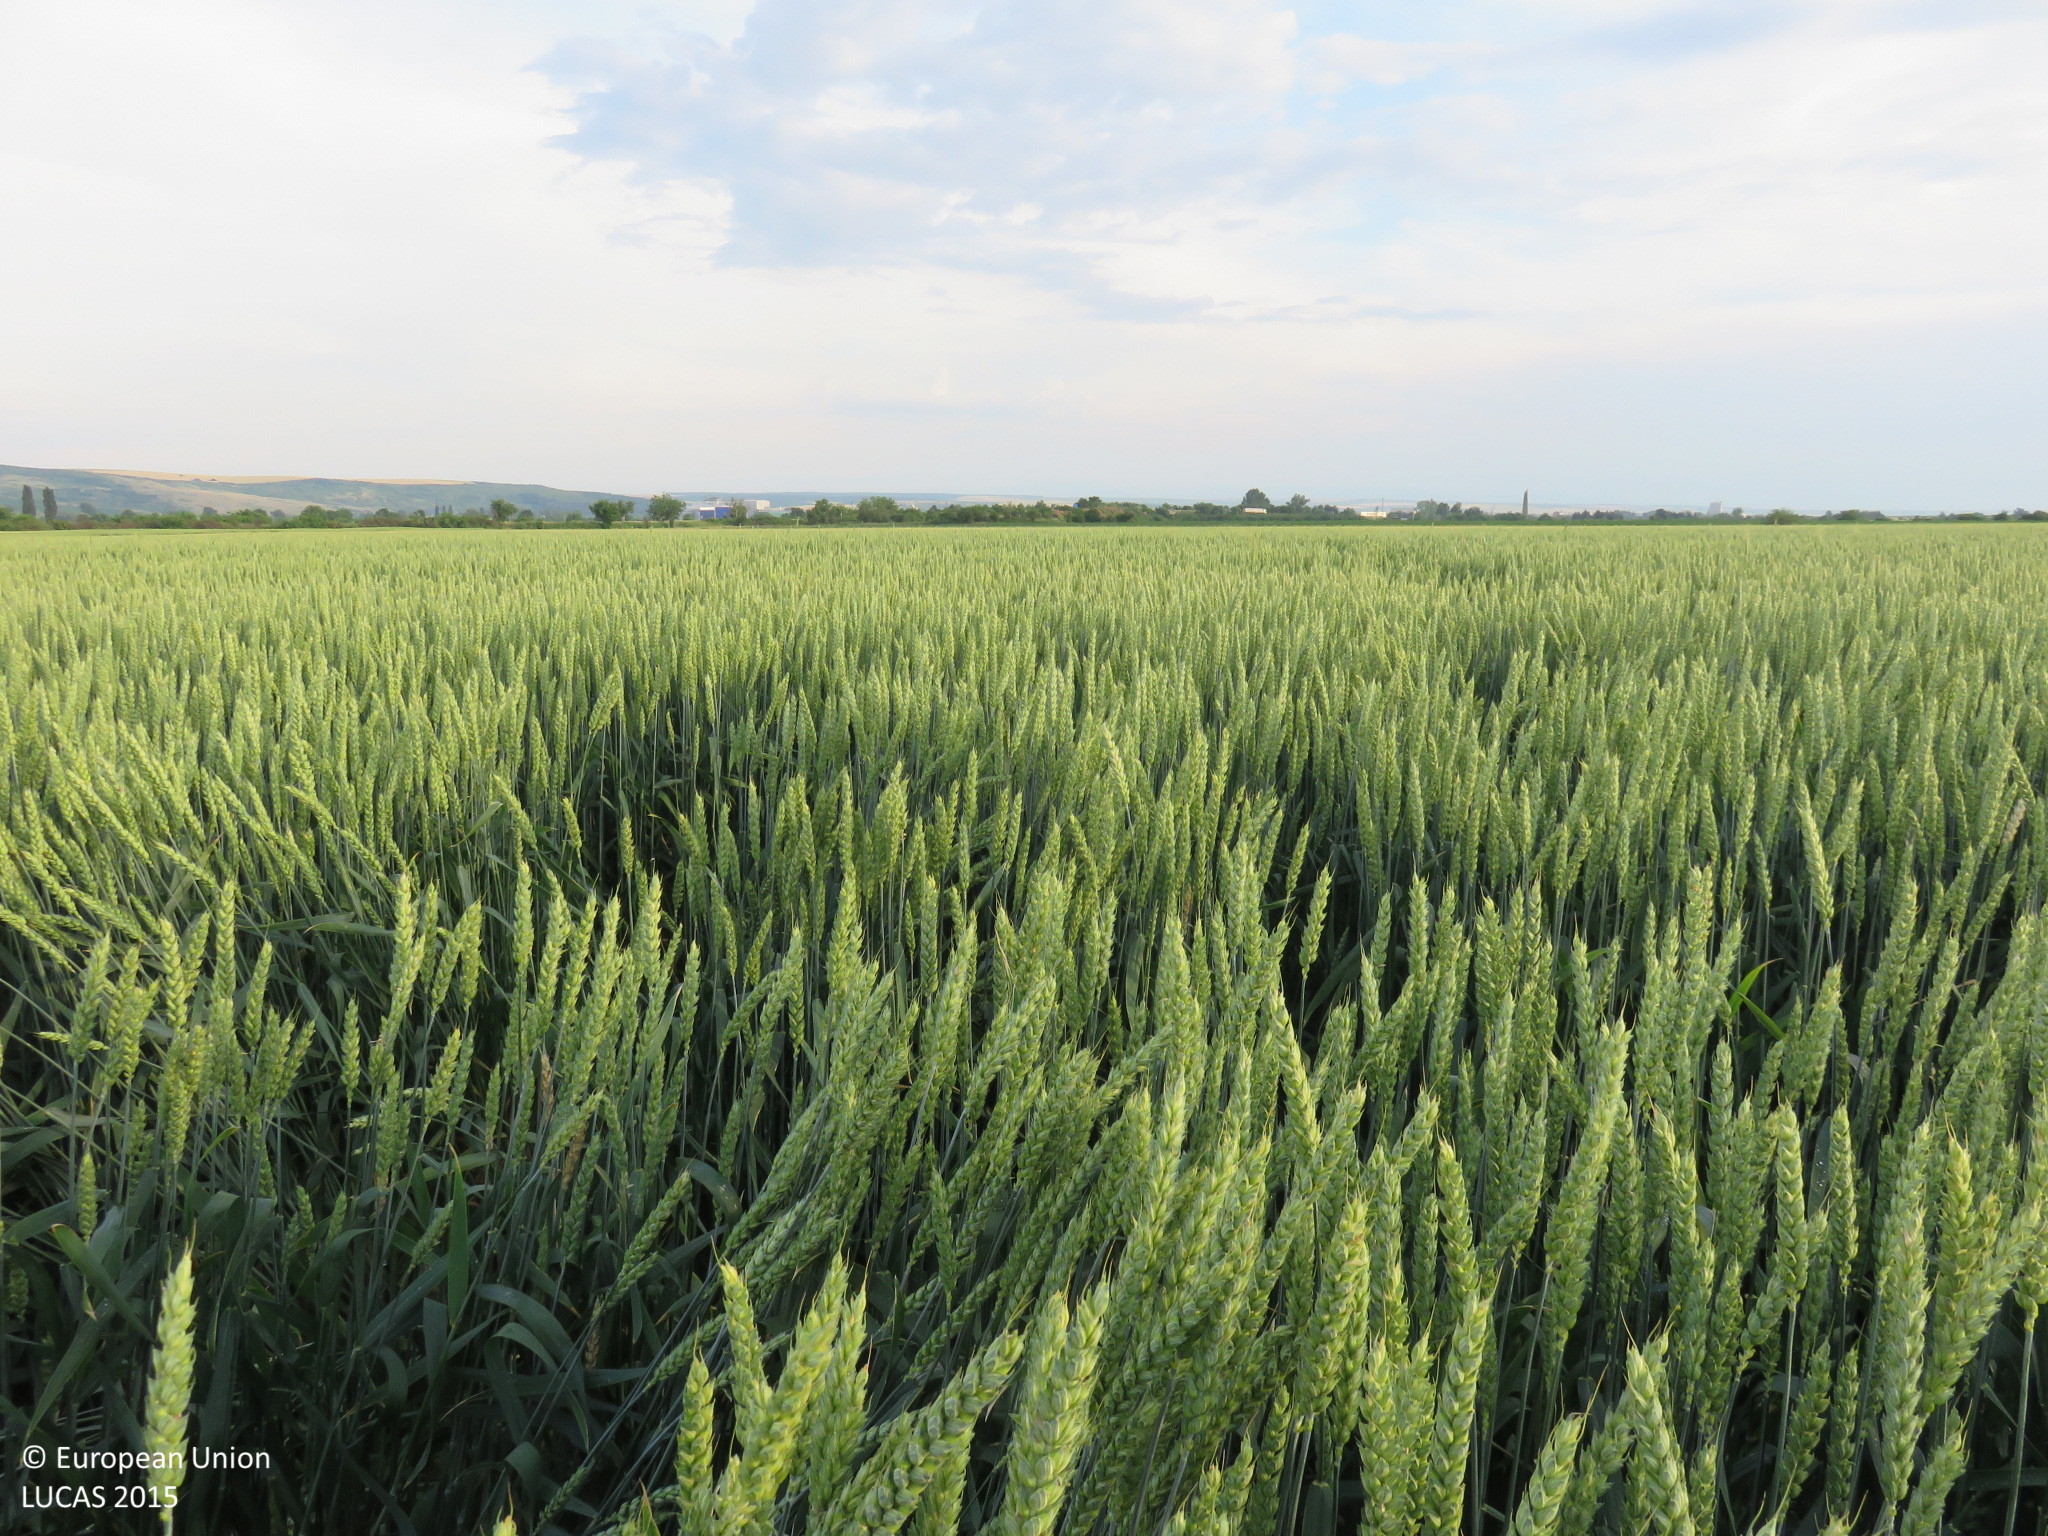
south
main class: Cropland
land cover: Common wheat
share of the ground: > 75 %
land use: Agriculture (excluding fallow land and kitchen gardens)
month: June
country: BG
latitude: 43.4351
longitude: 24.5032
